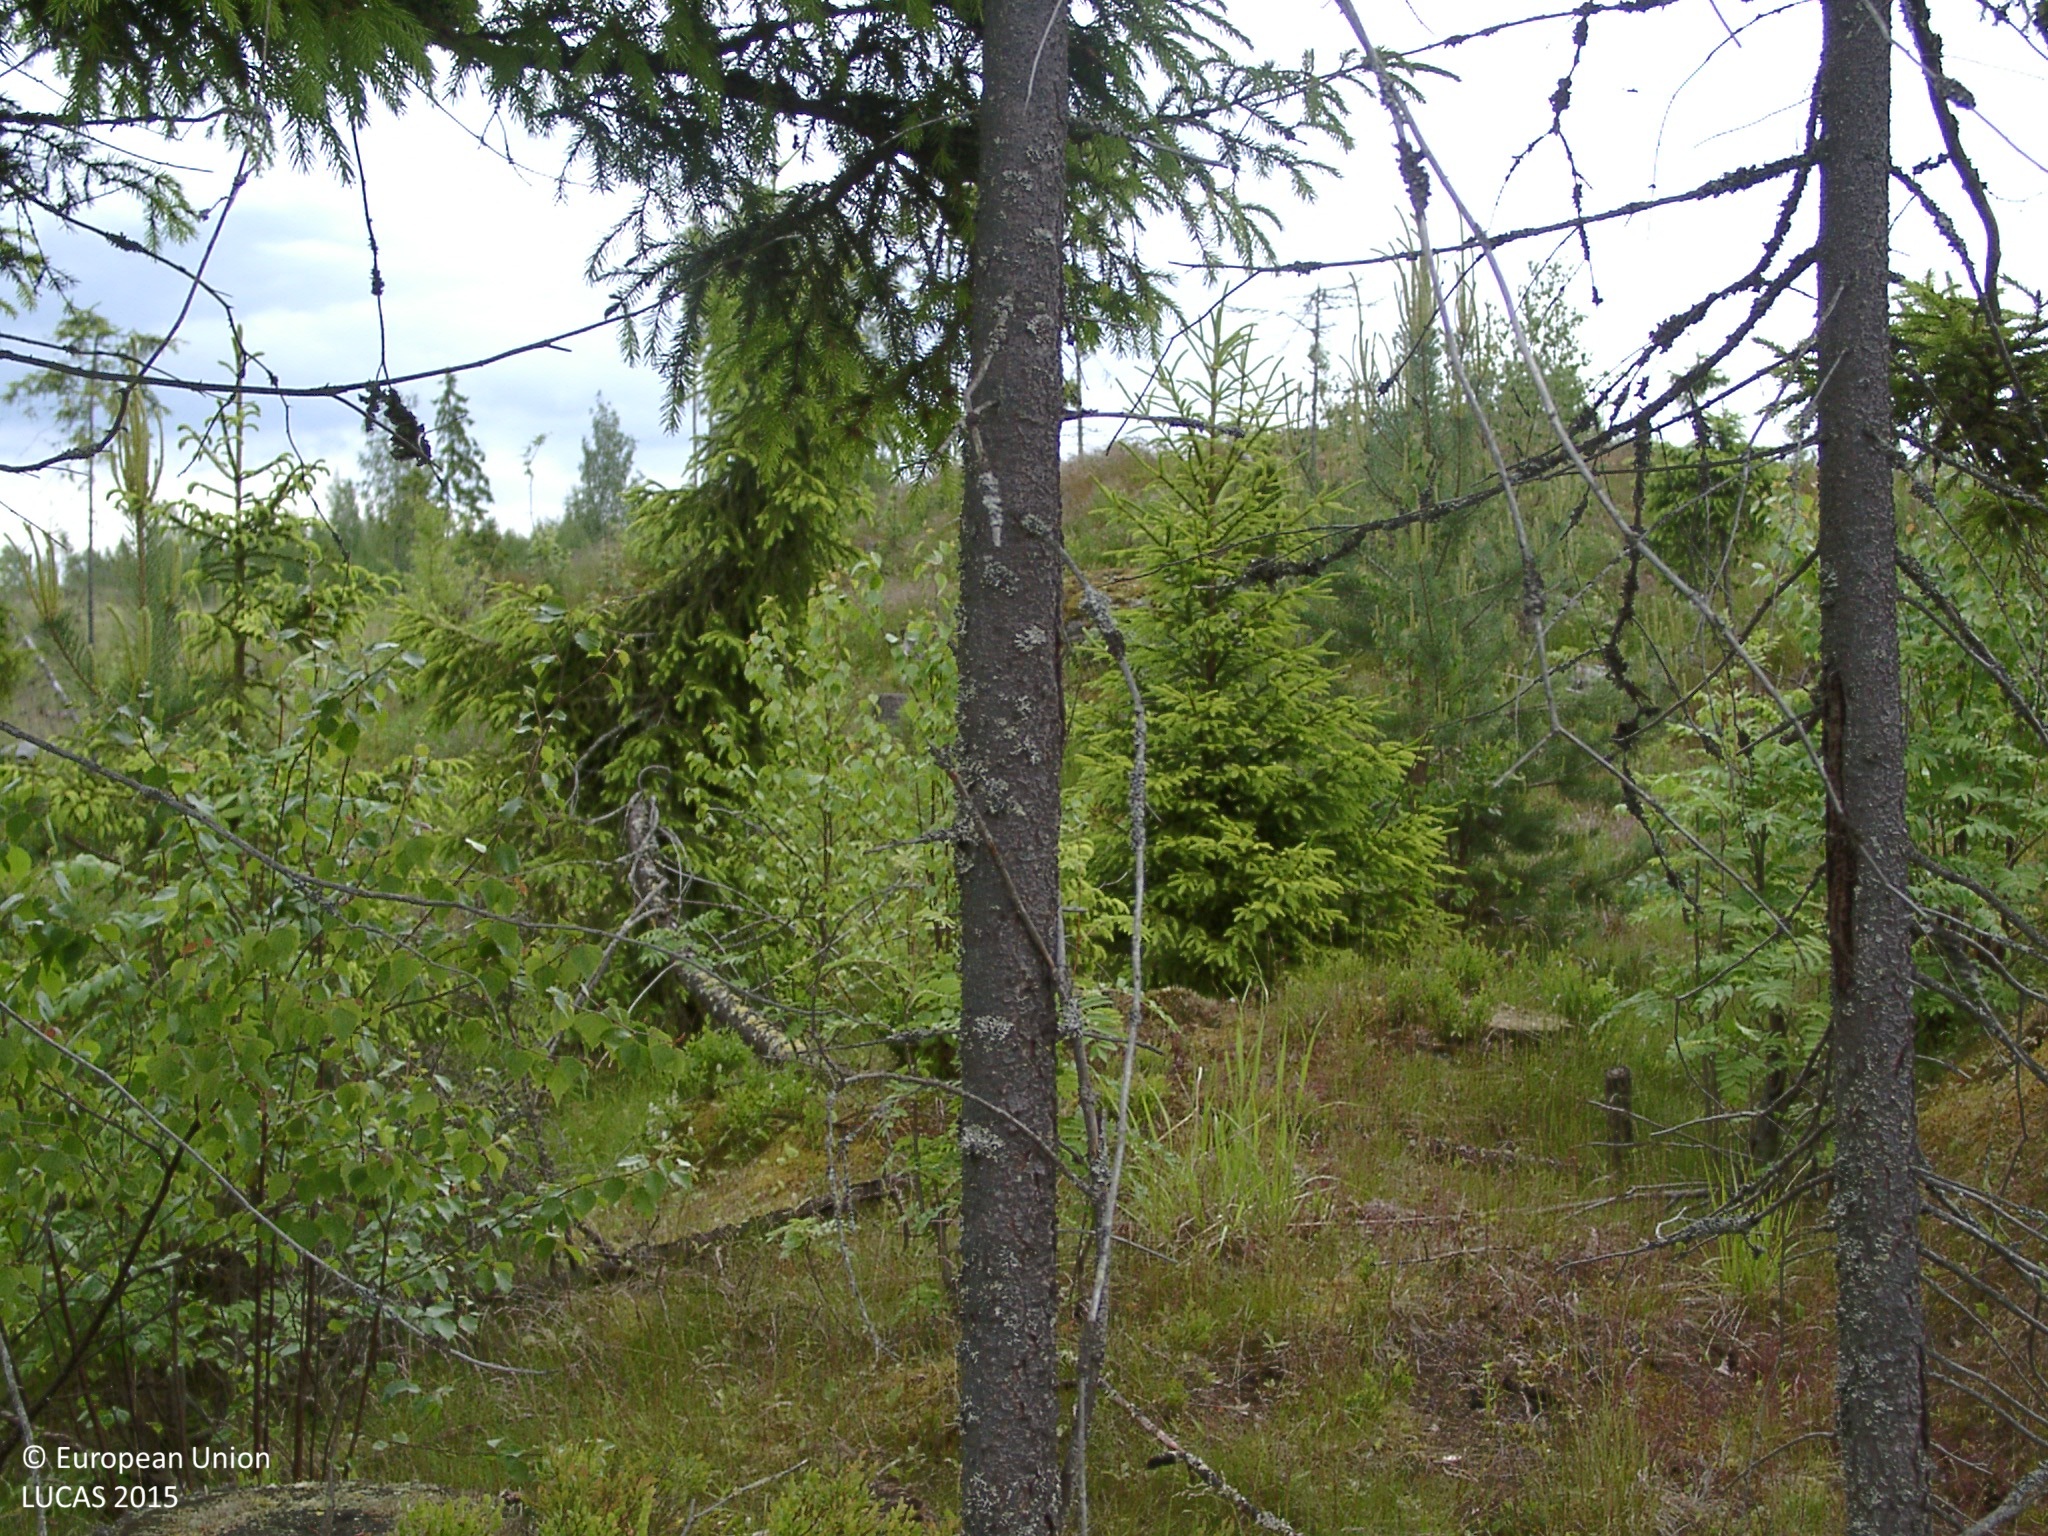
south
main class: Woodland
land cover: Other mixed woodland
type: boreal forest
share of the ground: 50 - 75 %
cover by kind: coniferous forest trees 35 %, broadleaved forest trees 35 %, herbaceous plants 15 %, shrubs 10 %, lichens and mosses 5 %
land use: Forestry
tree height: < 5 m
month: June
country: FI
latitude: 61.5716
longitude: 24.8878
